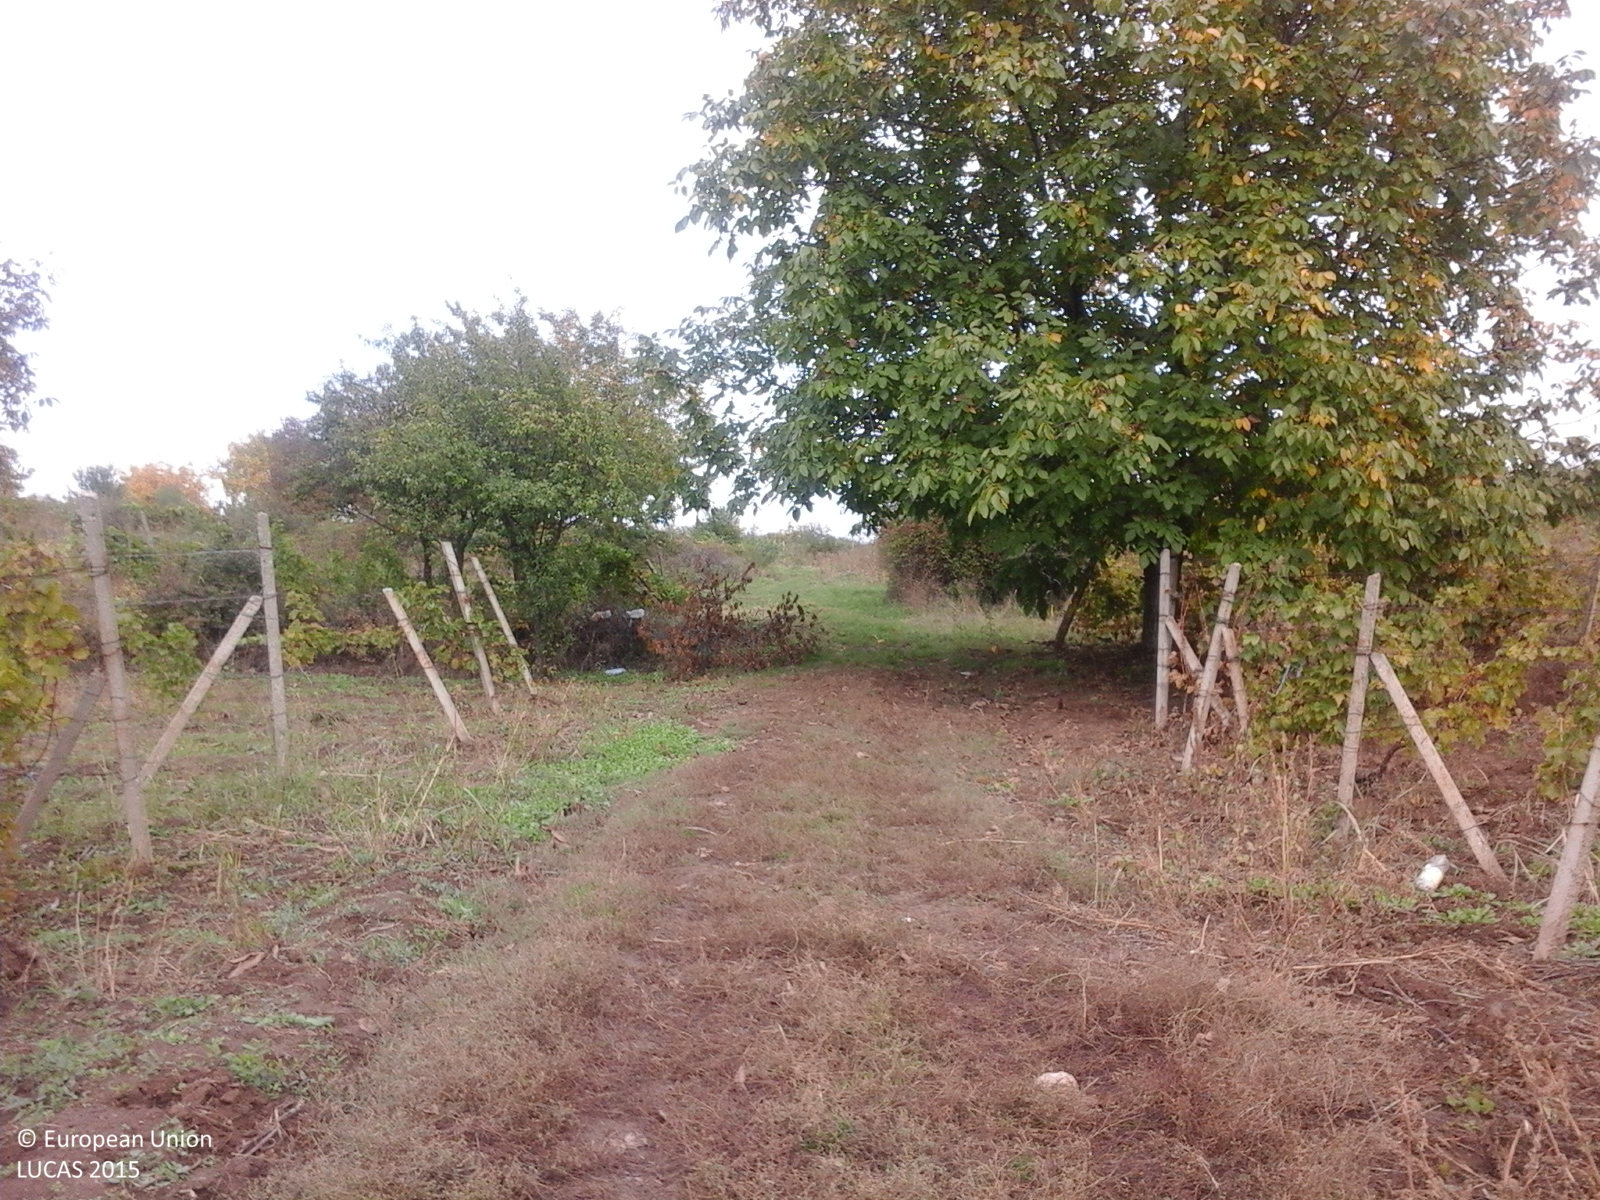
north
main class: Cropland
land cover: Vineyards
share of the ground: 25 - 50 %
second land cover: Grassland without tree/shrub cover
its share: > 75 %
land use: Agriculture (excluding fallow land and kitchen gardens)
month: October
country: RO
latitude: 45.0407
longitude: 26.3802
